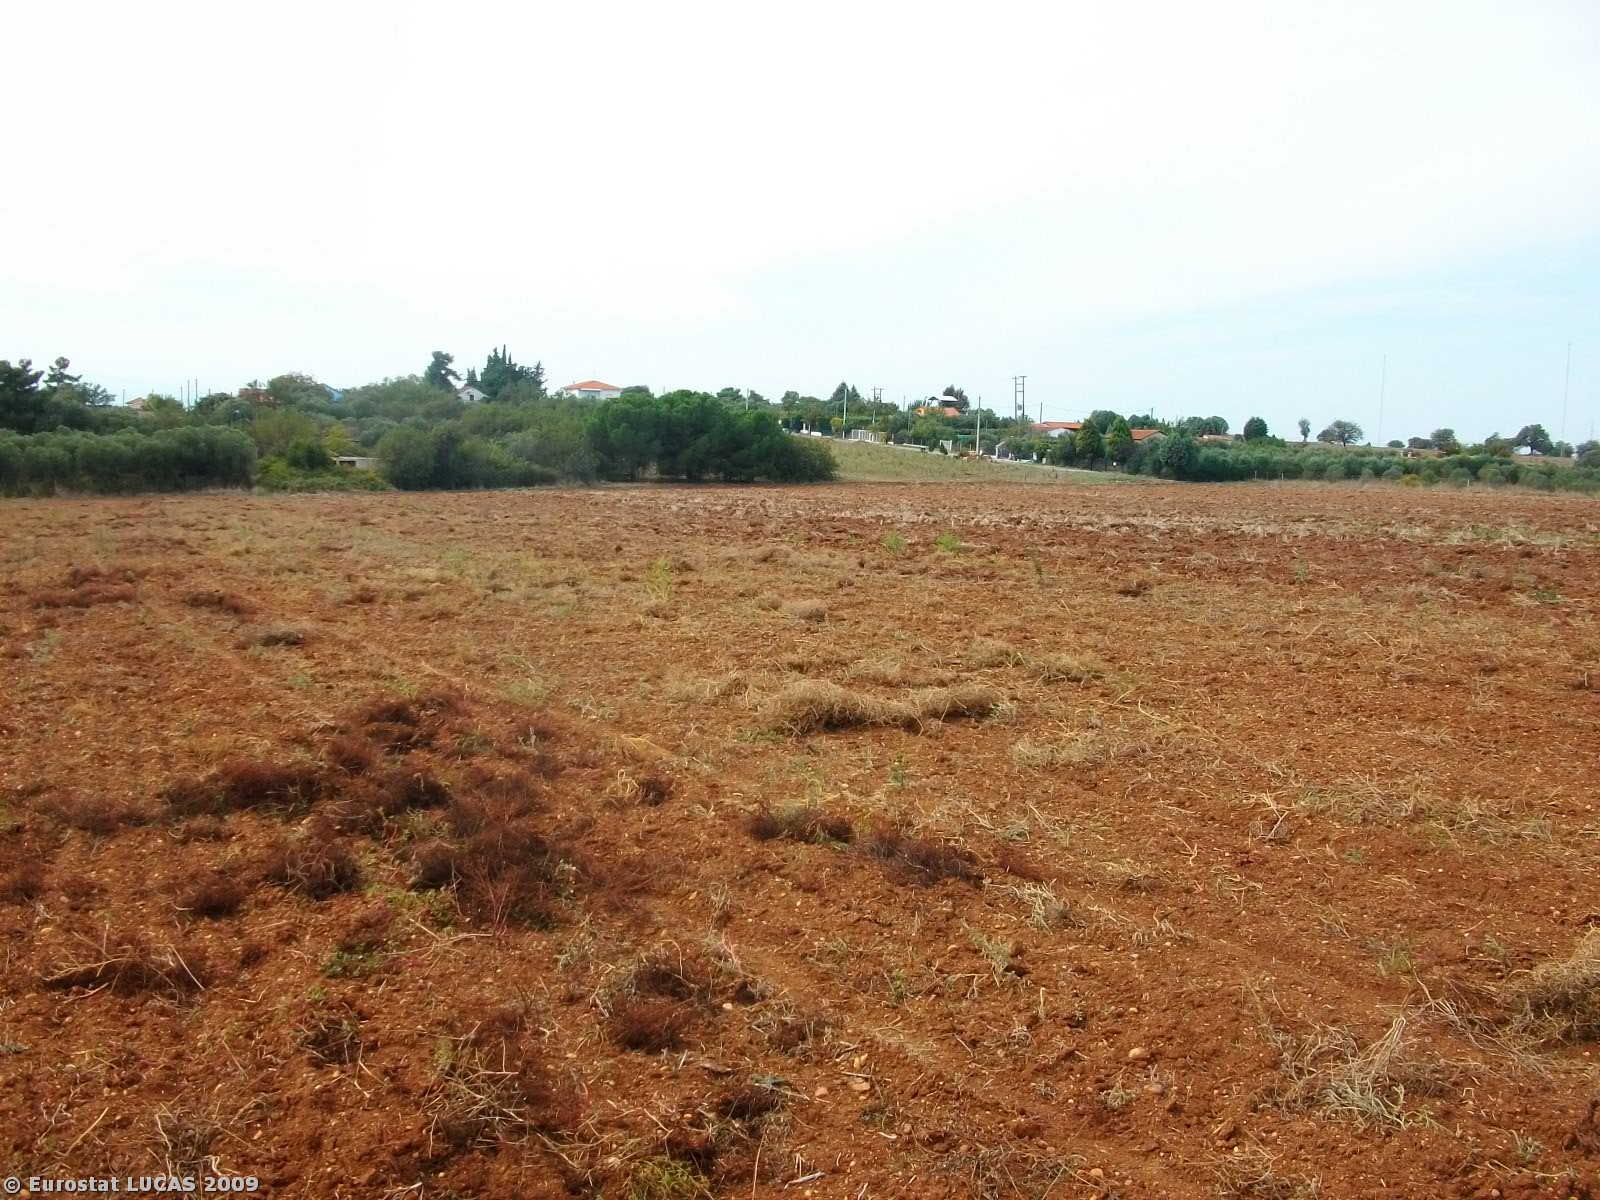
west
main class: Cropland
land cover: Common wheat
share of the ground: < 10 %
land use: Agriculture (excluding fallow land and kitchen gardens)
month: September
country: GR
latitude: 40.5002
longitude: 22.8307
